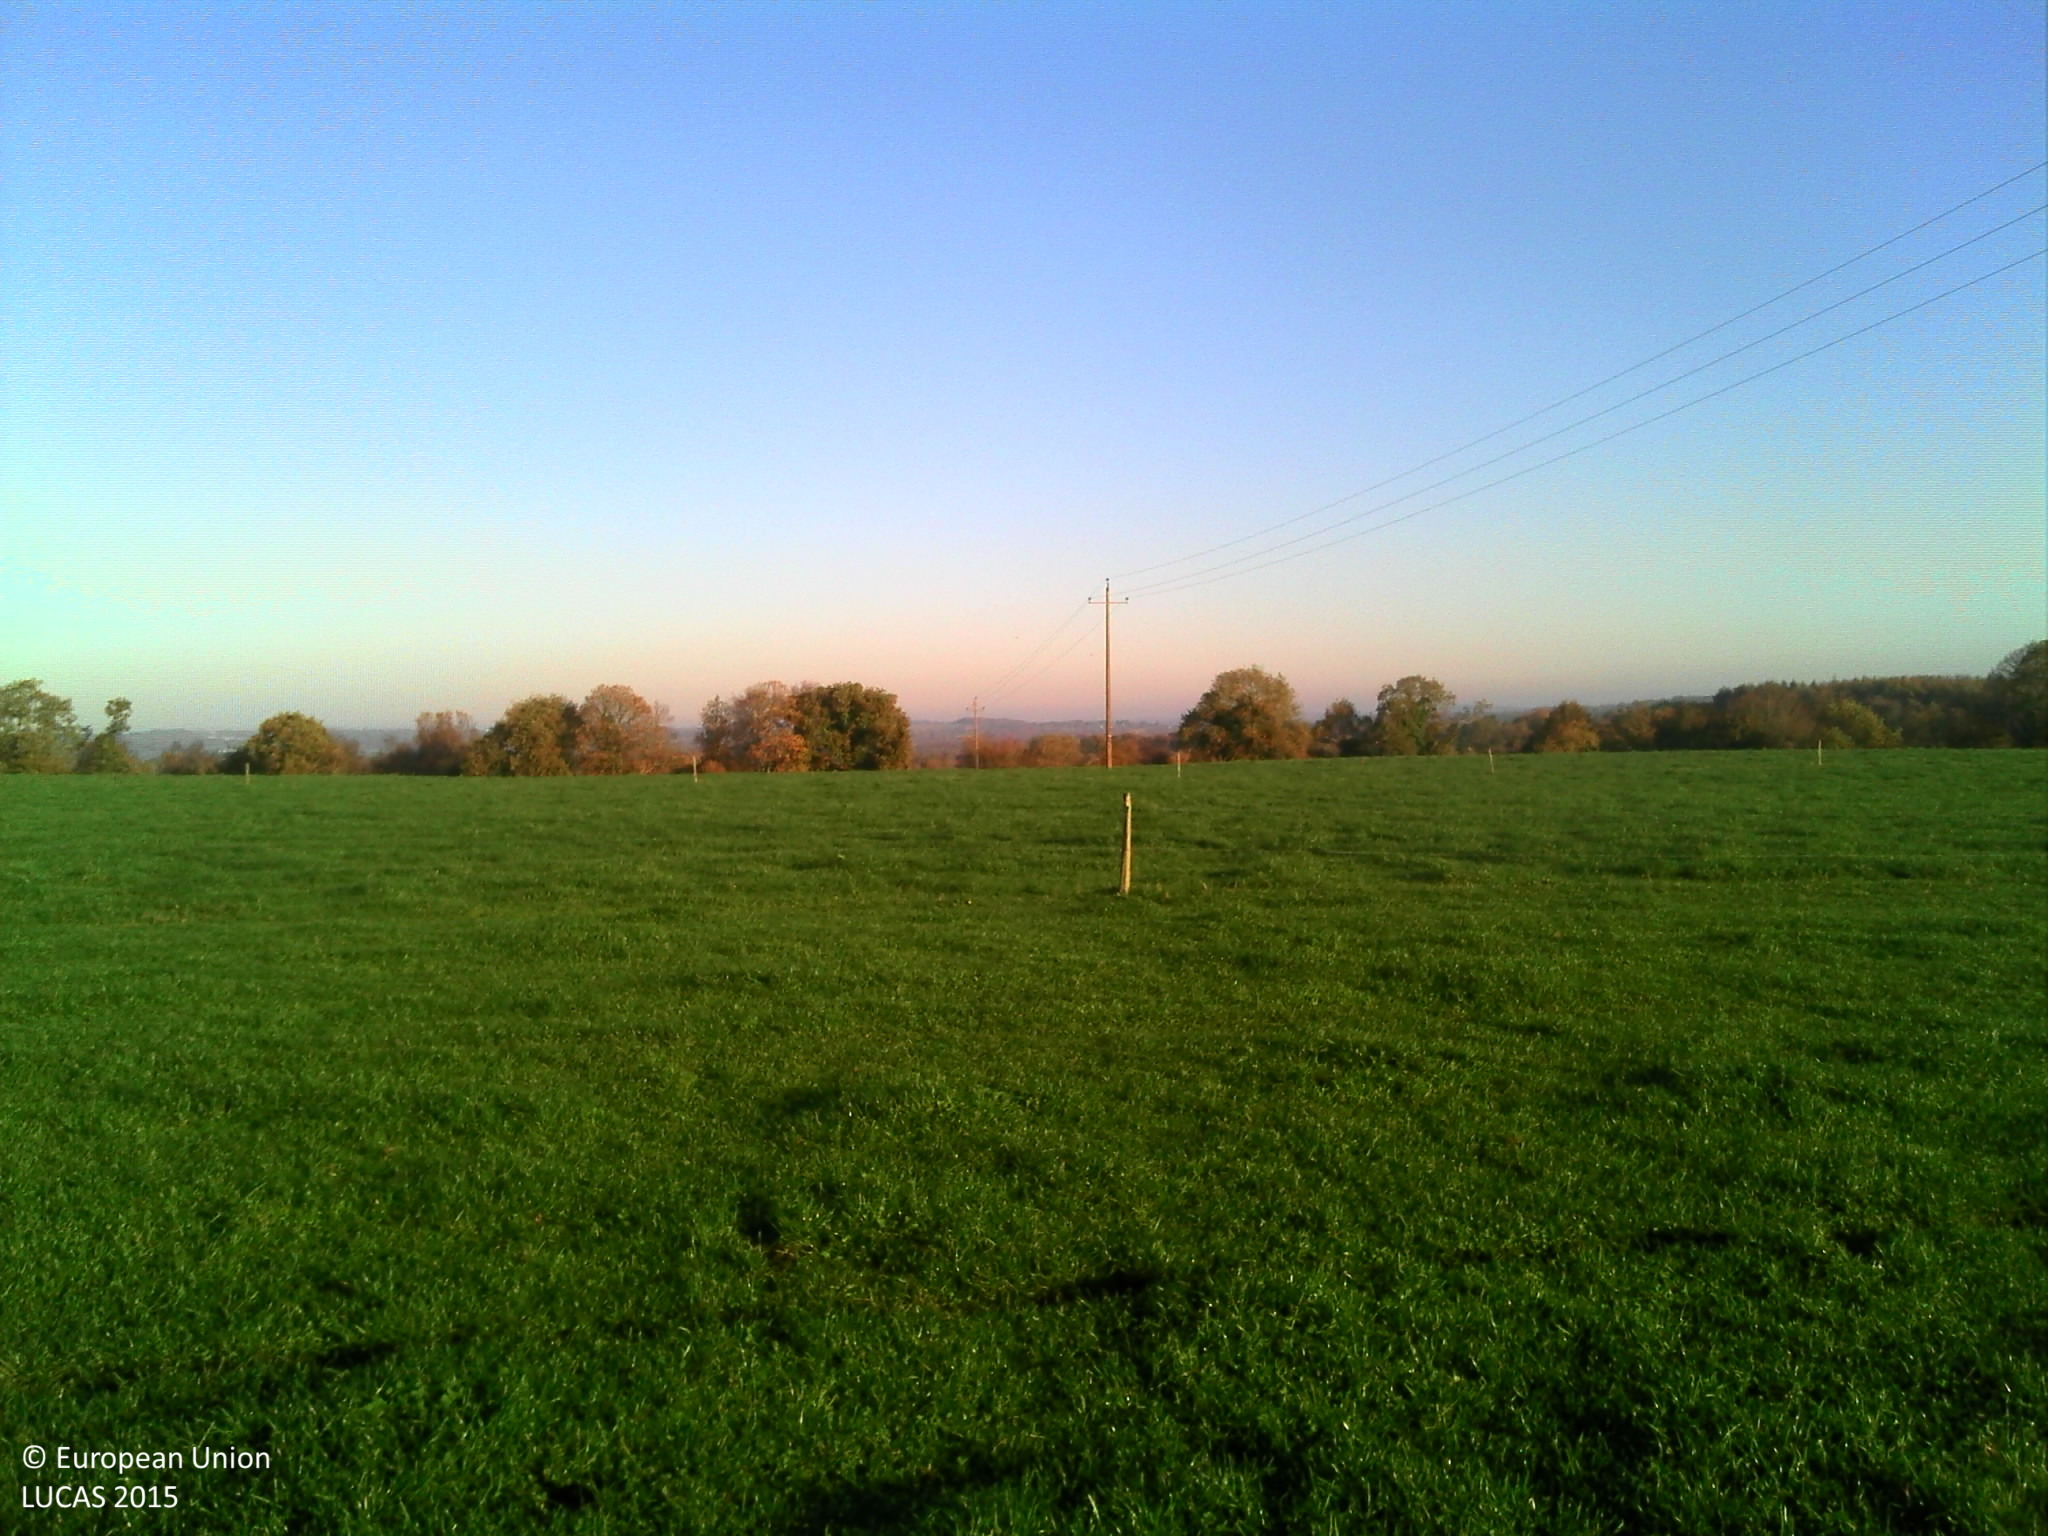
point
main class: Grassland
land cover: Grassland without tree/shrub cover
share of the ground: > 75 %
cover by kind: herbaceous plants 100 %
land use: Agriculture (excluding fallow land and kitchen gardens)
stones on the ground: < 10 %
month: November
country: FR
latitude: 48.1348
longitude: -3.3646
